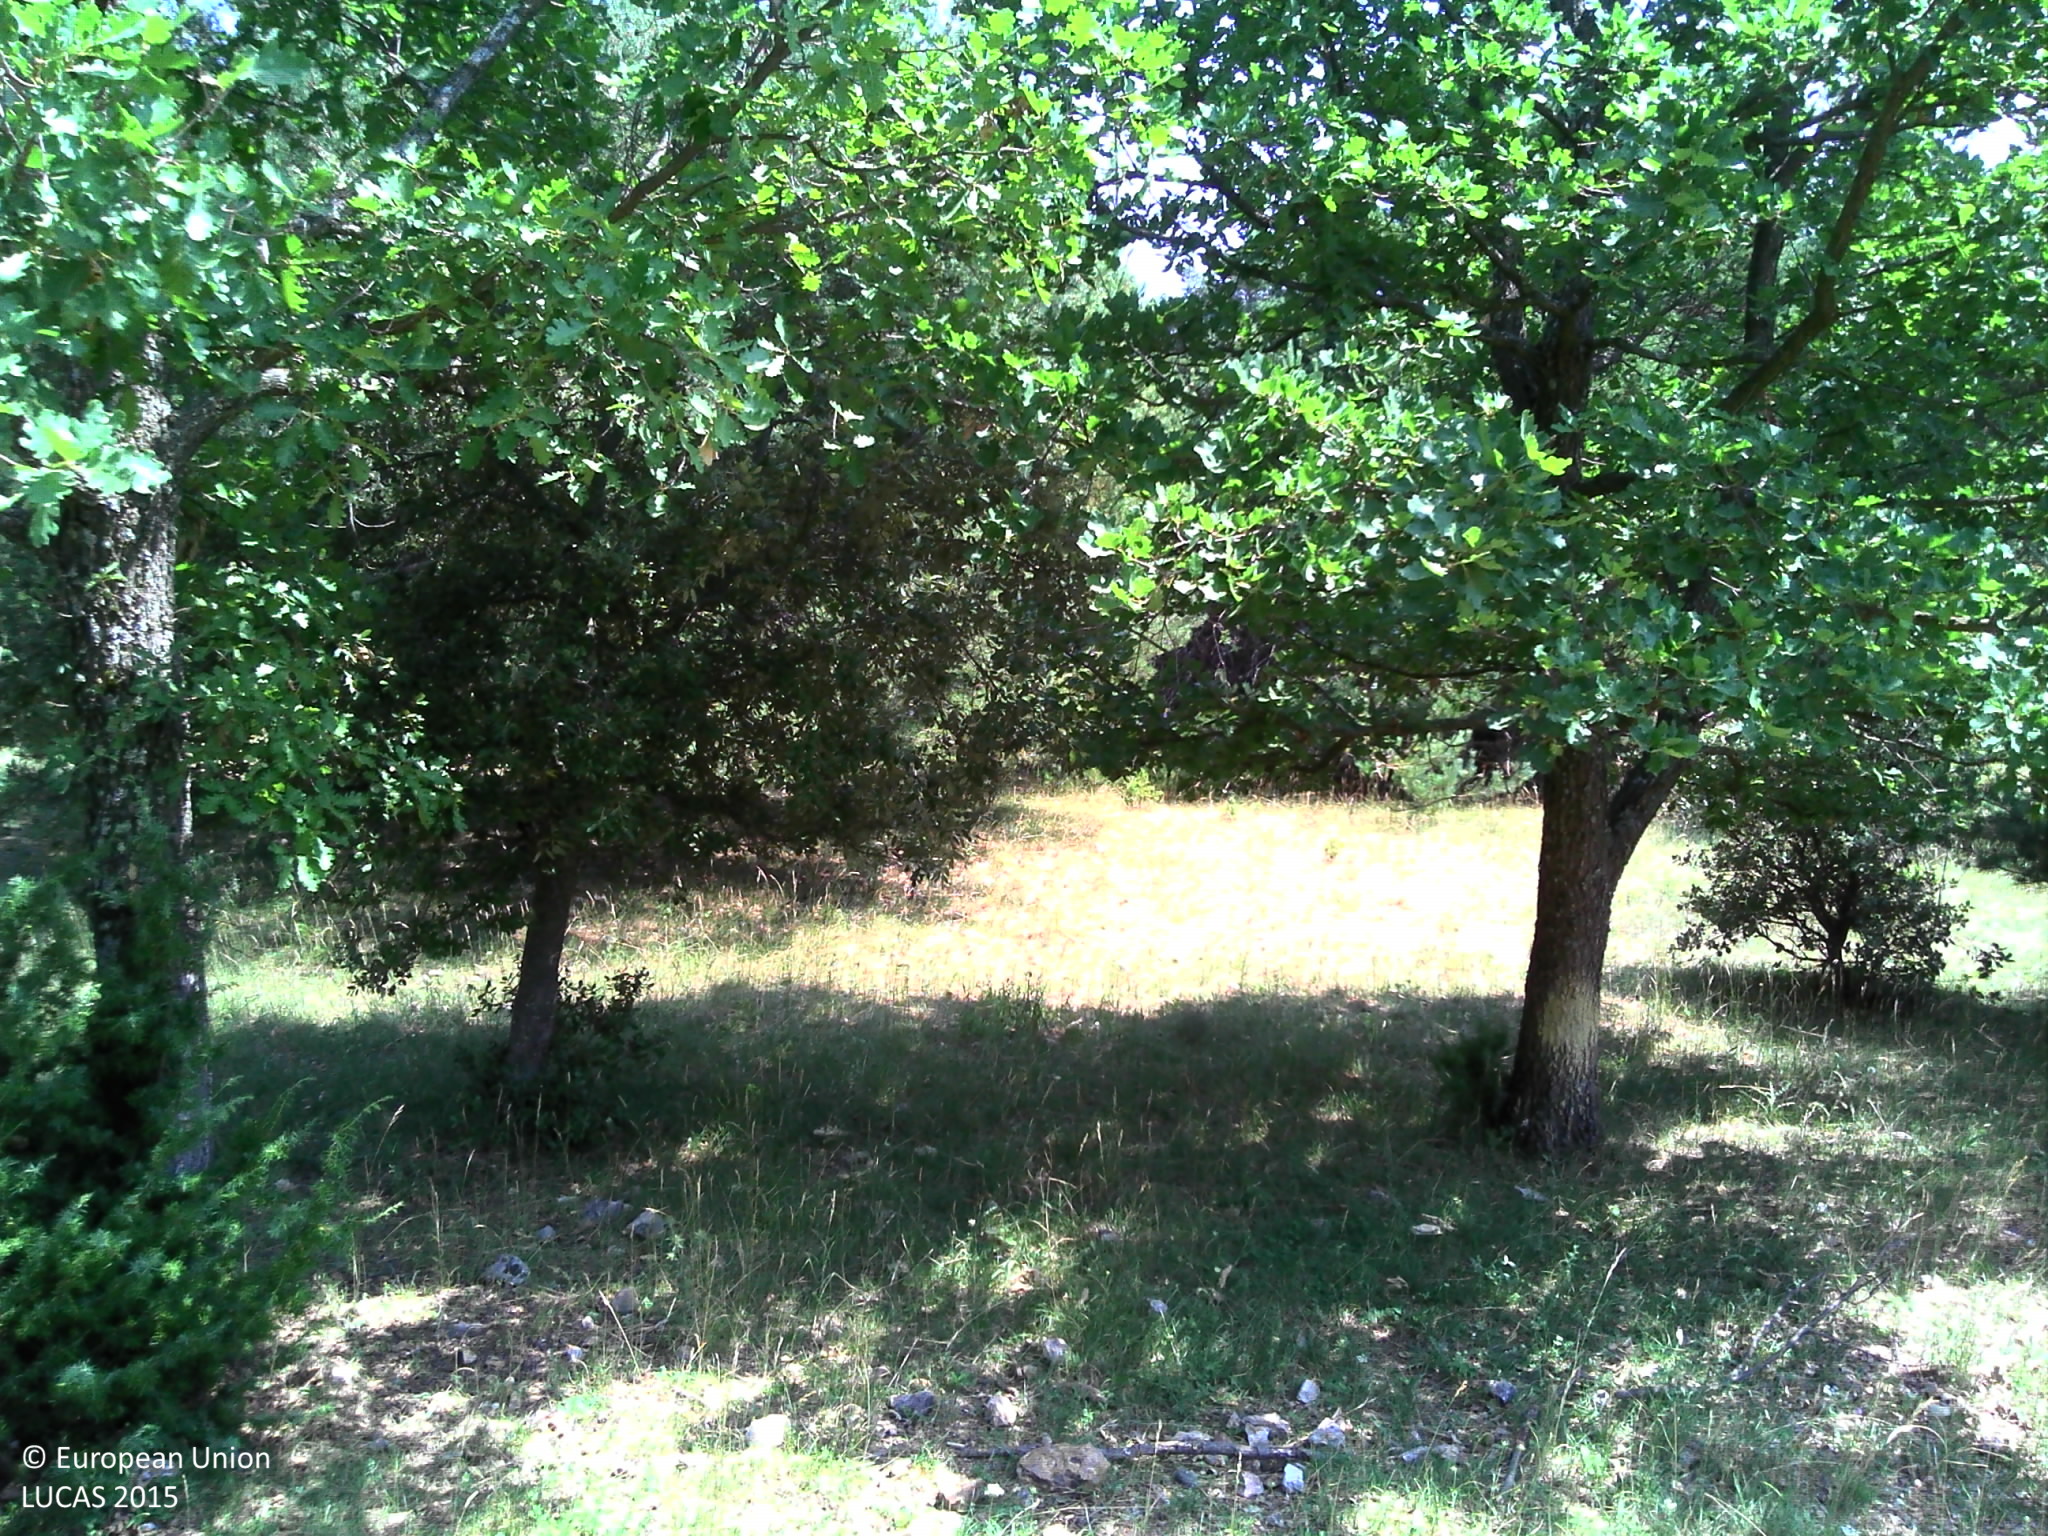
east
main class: Woodland
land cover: Broadleaved woodland
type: broadleaved evergreen forest
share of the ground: 50 - 75 %
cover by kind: herbaceous plants 45 %, broadleaved forest trees 40 %, shrubs 10 %, coniferous forest trees 5 %
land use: Agriculture (excluding fallow land and kitchen gardens)
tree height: > 5 m
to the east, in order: Broadleaved woodland; Pine dominated mixed woodland; Tracks; Pine dominated mixed woodland; Shrubland with sparse tree cover; Broadleaved woodland
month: July
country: FR
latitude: 44.0095
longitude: 5.3061
